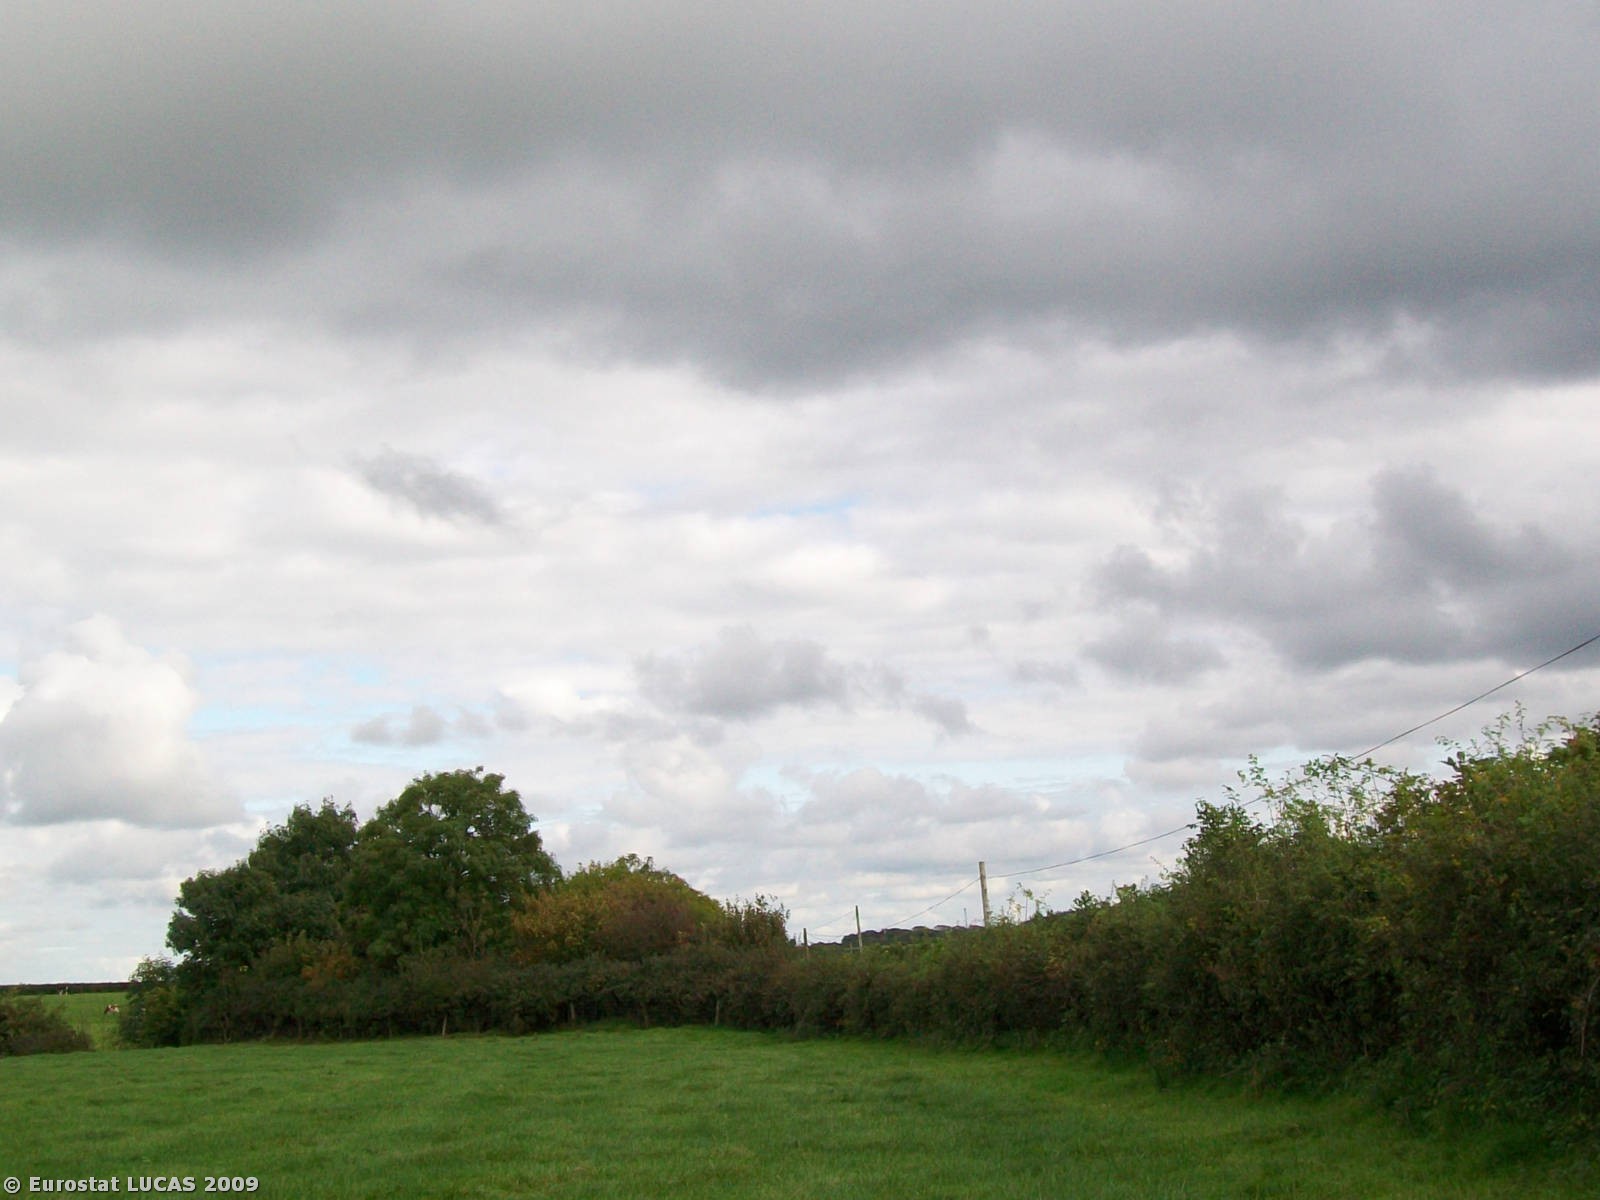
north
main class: Grassland
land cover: Grassland without tree/shrub cover
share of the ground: > 75 %
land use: Agriculture (excluding fallow land and kitchen gardens)
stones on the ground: < 10 %
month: October
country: GB
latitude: 51.8363
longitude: -4.7250
